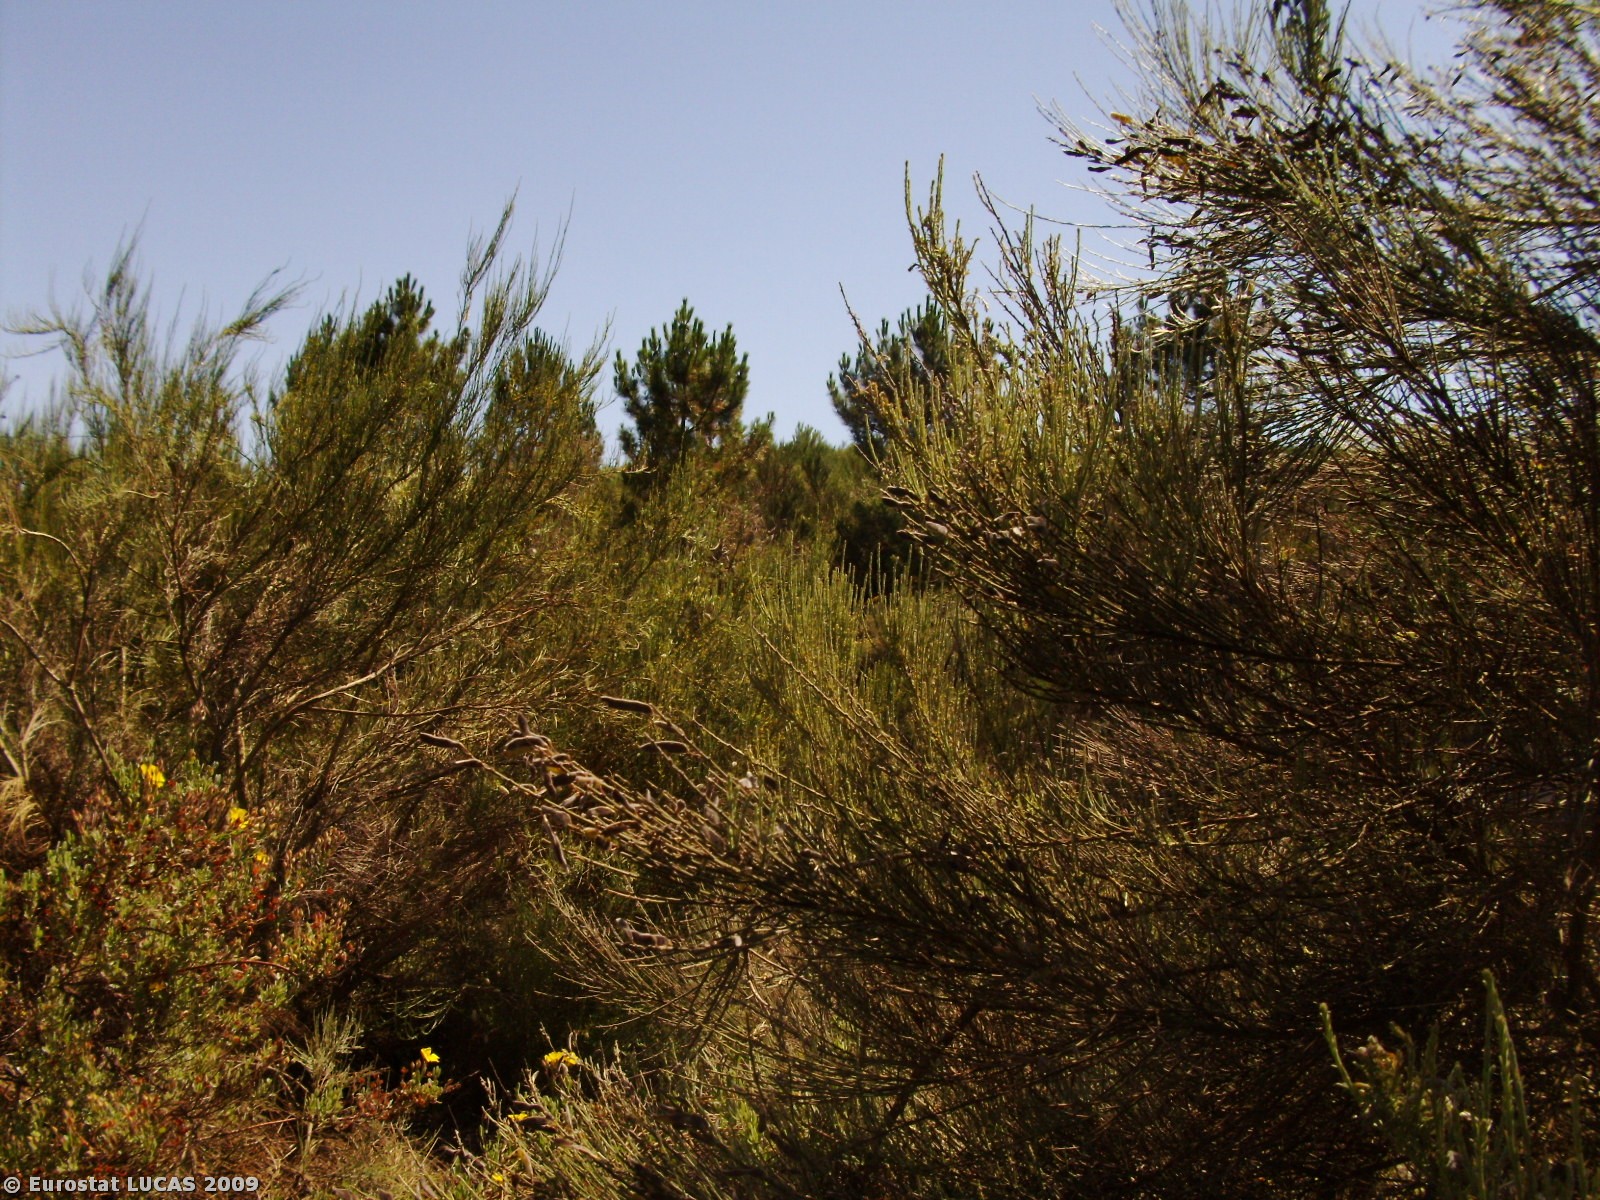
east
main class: Woodland
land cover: Coniferous woodland
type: coniferous forest of the mediterranean region
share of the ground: 25 - 50 %
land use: Forestry
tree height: > 5 m
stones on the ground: < 10 %
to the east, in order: Coniferous woodland; Grass margins; Paved roads, cycling and walking lanes; Grass margins; Shrubland with sparse tree cover
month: July
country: PT
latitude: 40.9790
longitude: -7.7505
